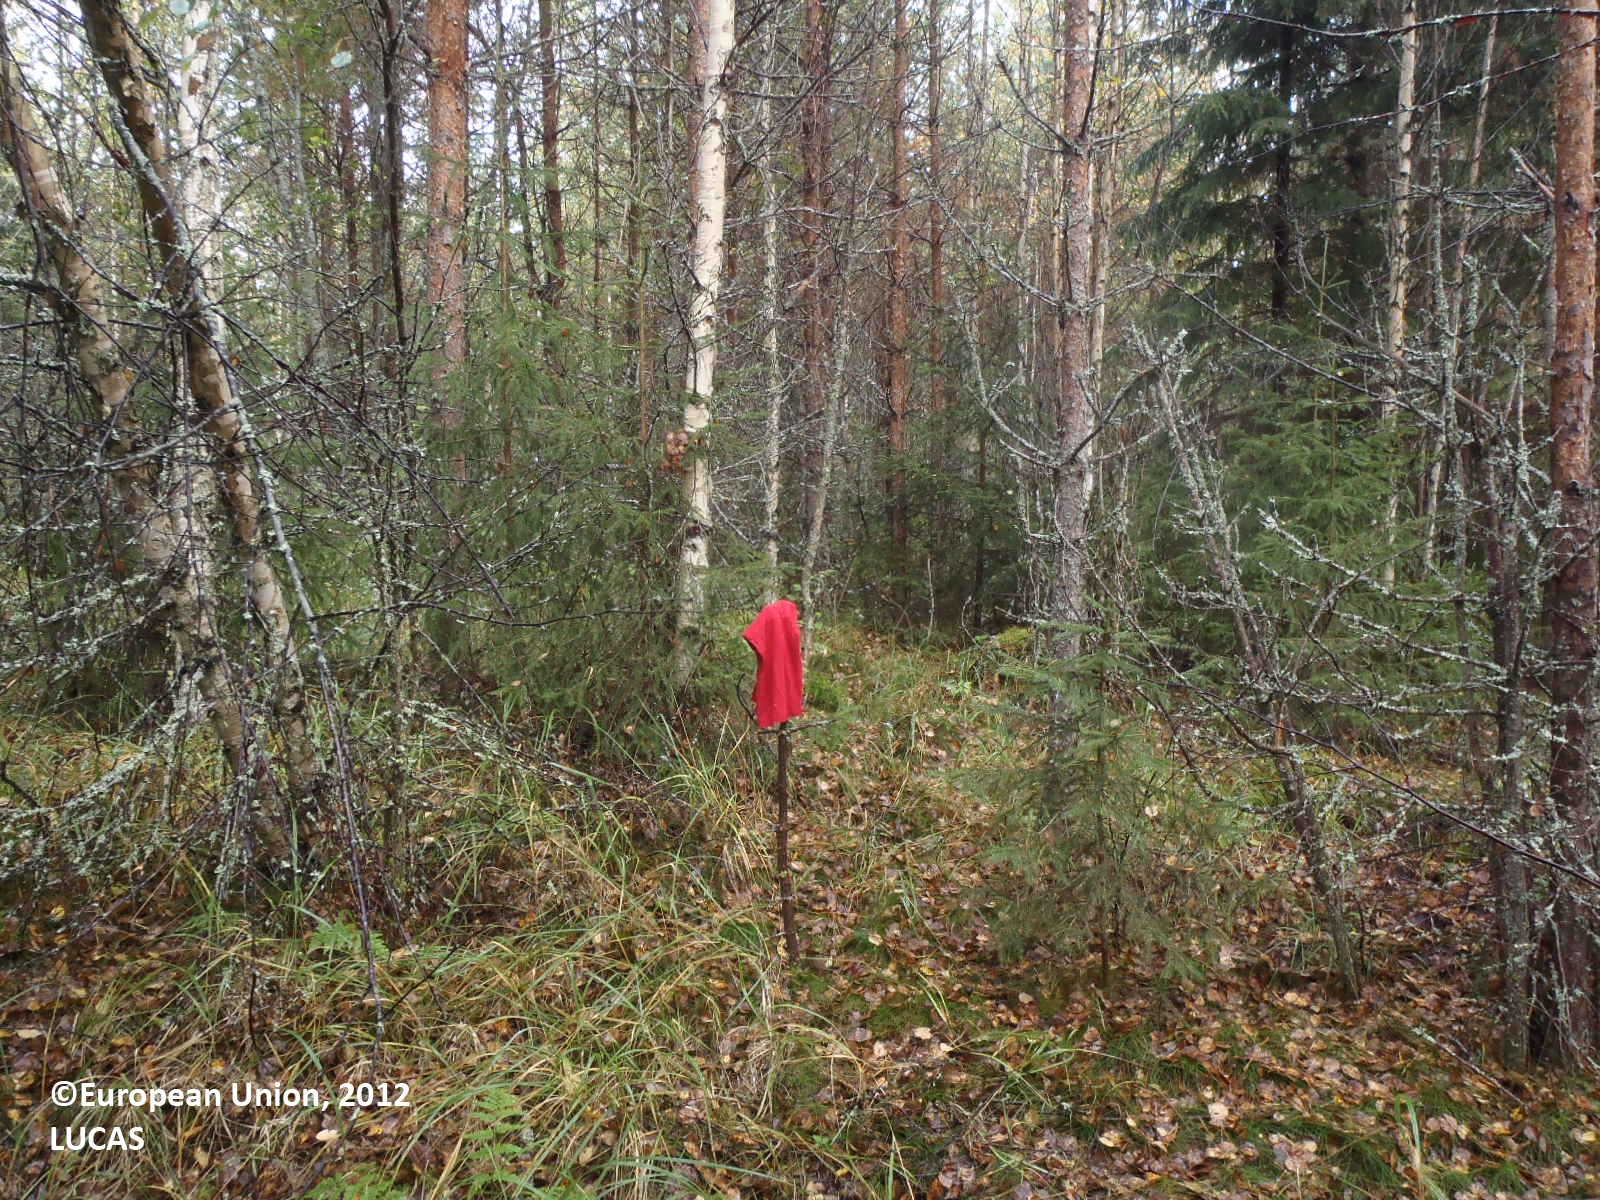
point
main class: Woodland
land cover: Pine dominated mixed woodland
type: boreal forest
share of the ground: > 75 %
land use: Forestry
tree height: > 5 m
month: September
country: FI
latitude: 61.6771
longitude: 22.8205
